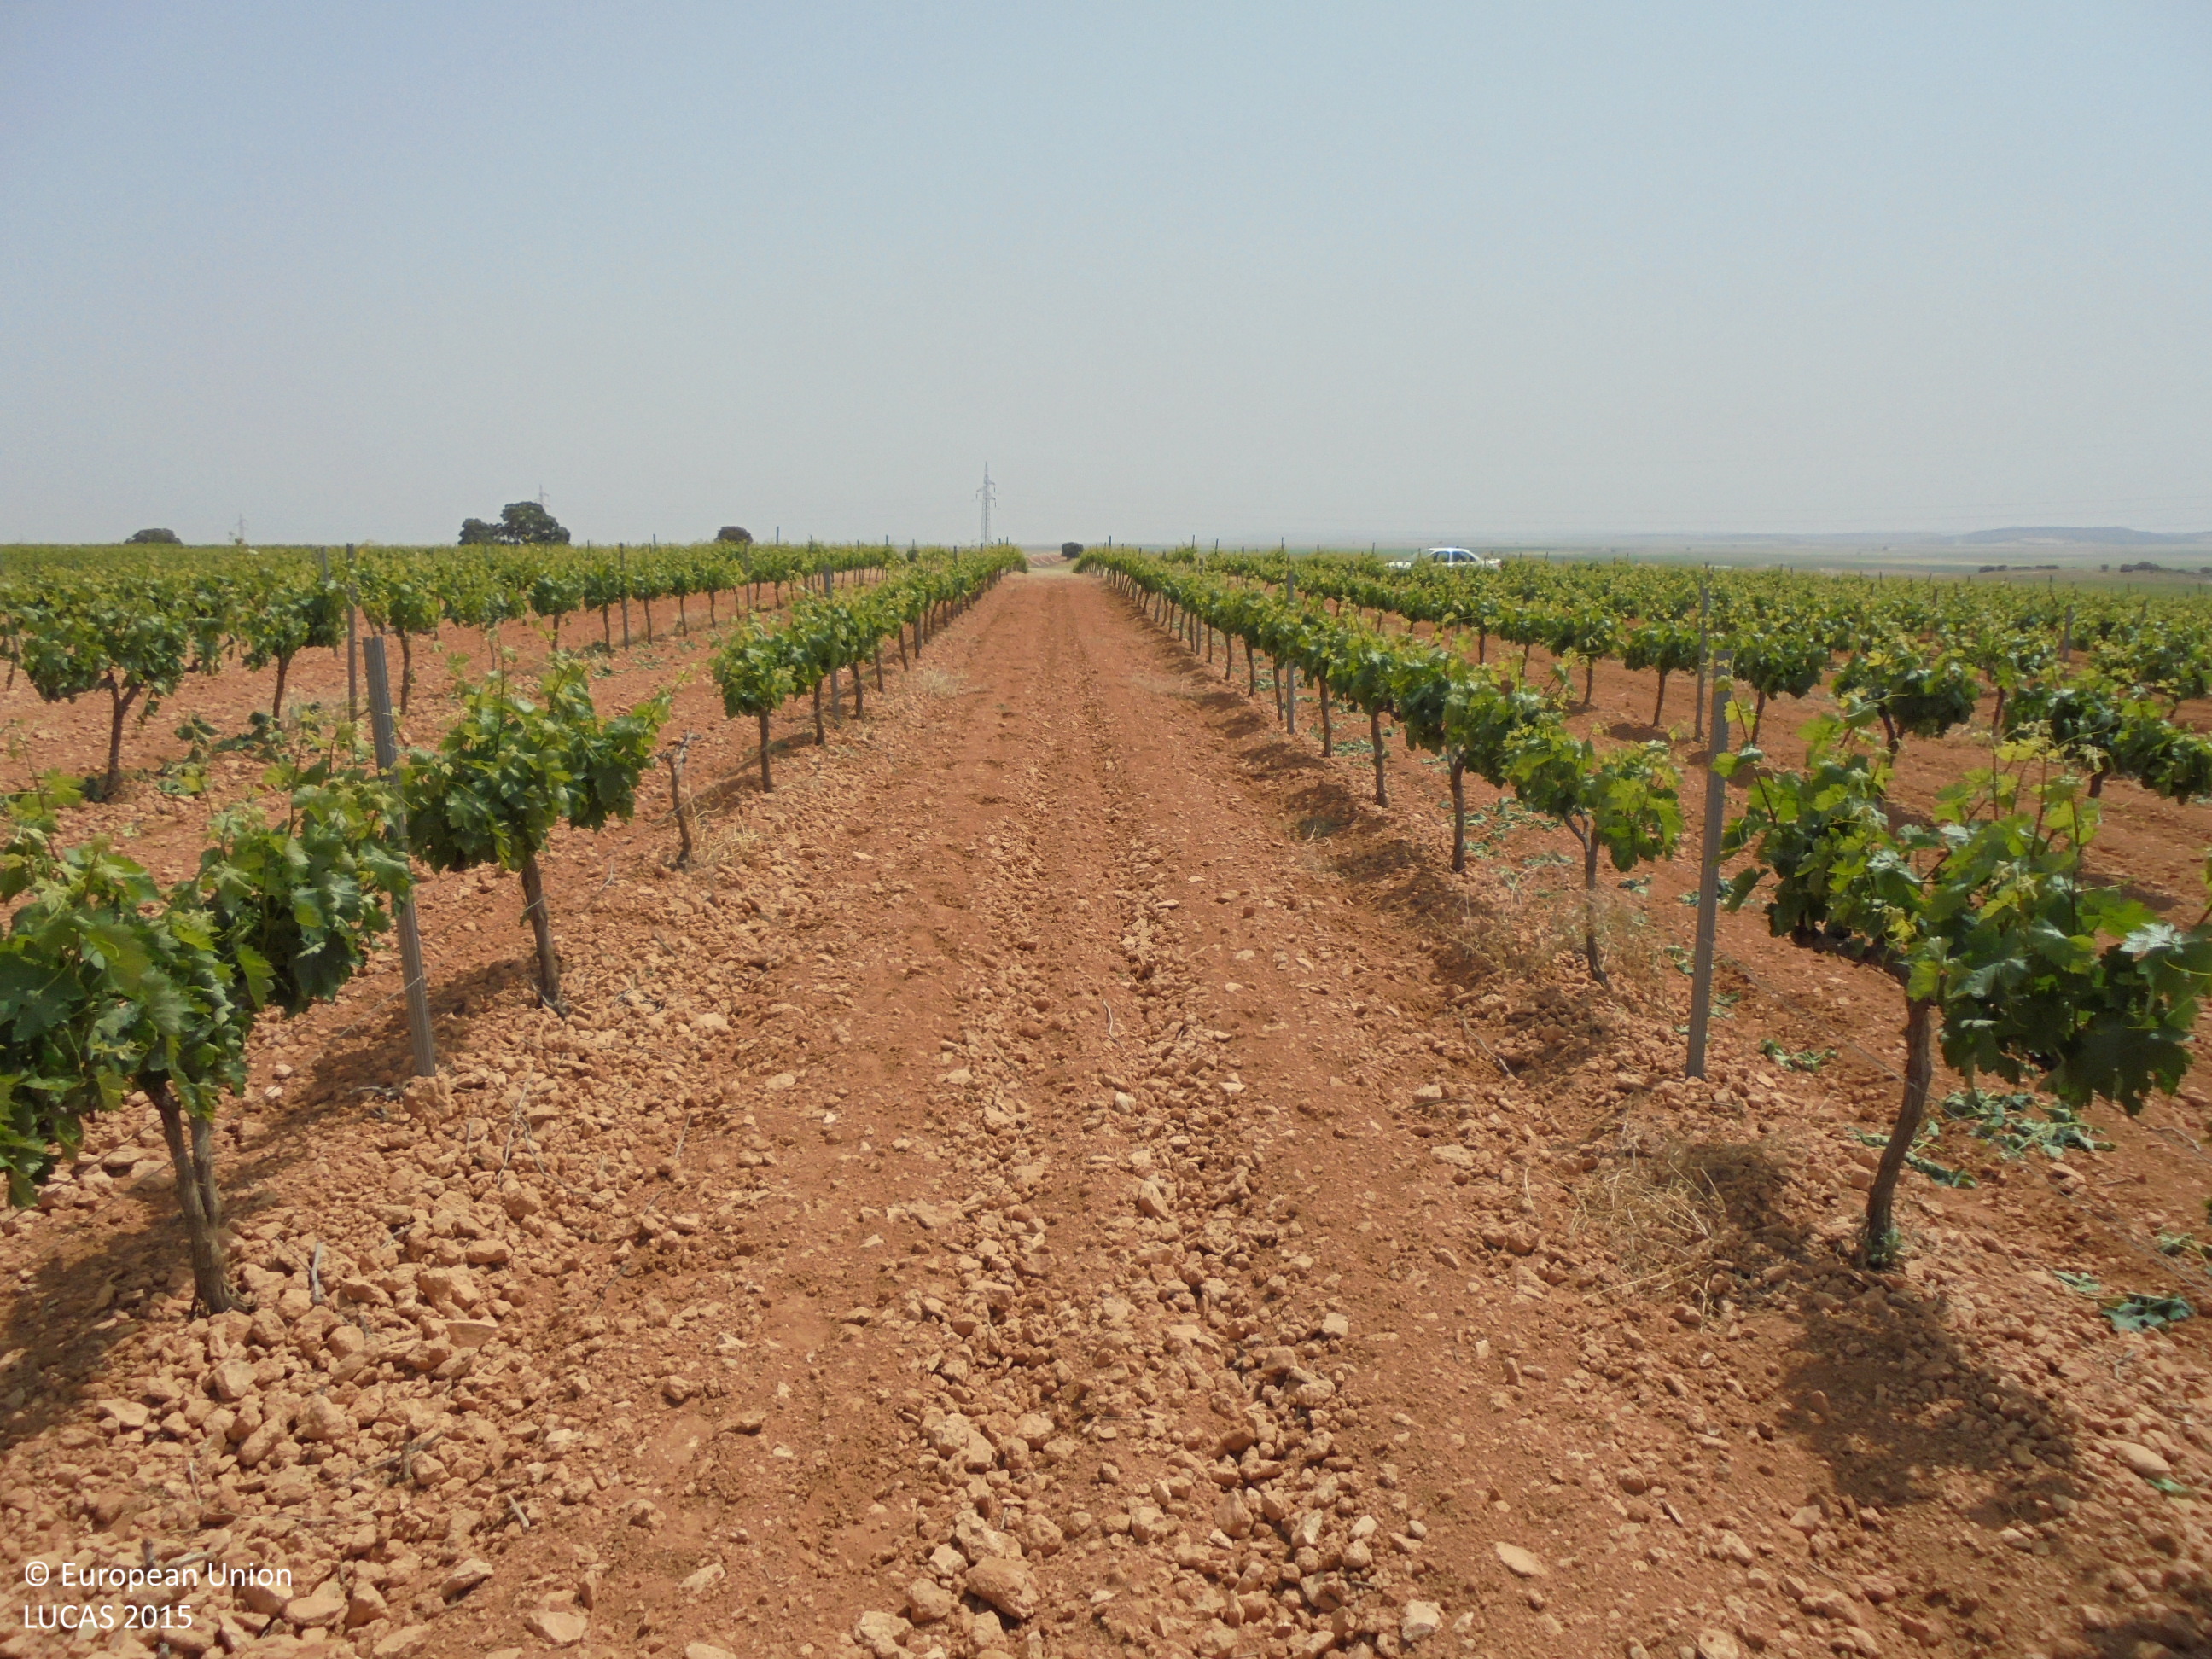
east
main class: Cropland
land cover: Vineyards
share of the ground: 10 - 25 %
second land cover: Other bare soil
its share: > 75 %
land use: Agriculture (excluding fallow land and kitchen gardens)
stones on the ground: > 50 %
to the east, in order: Vineyards; Other bare soil; Grass margins; Tracks; Grass margins; Barley
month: May
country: ES
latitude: 39.0910
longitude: -1.6891
